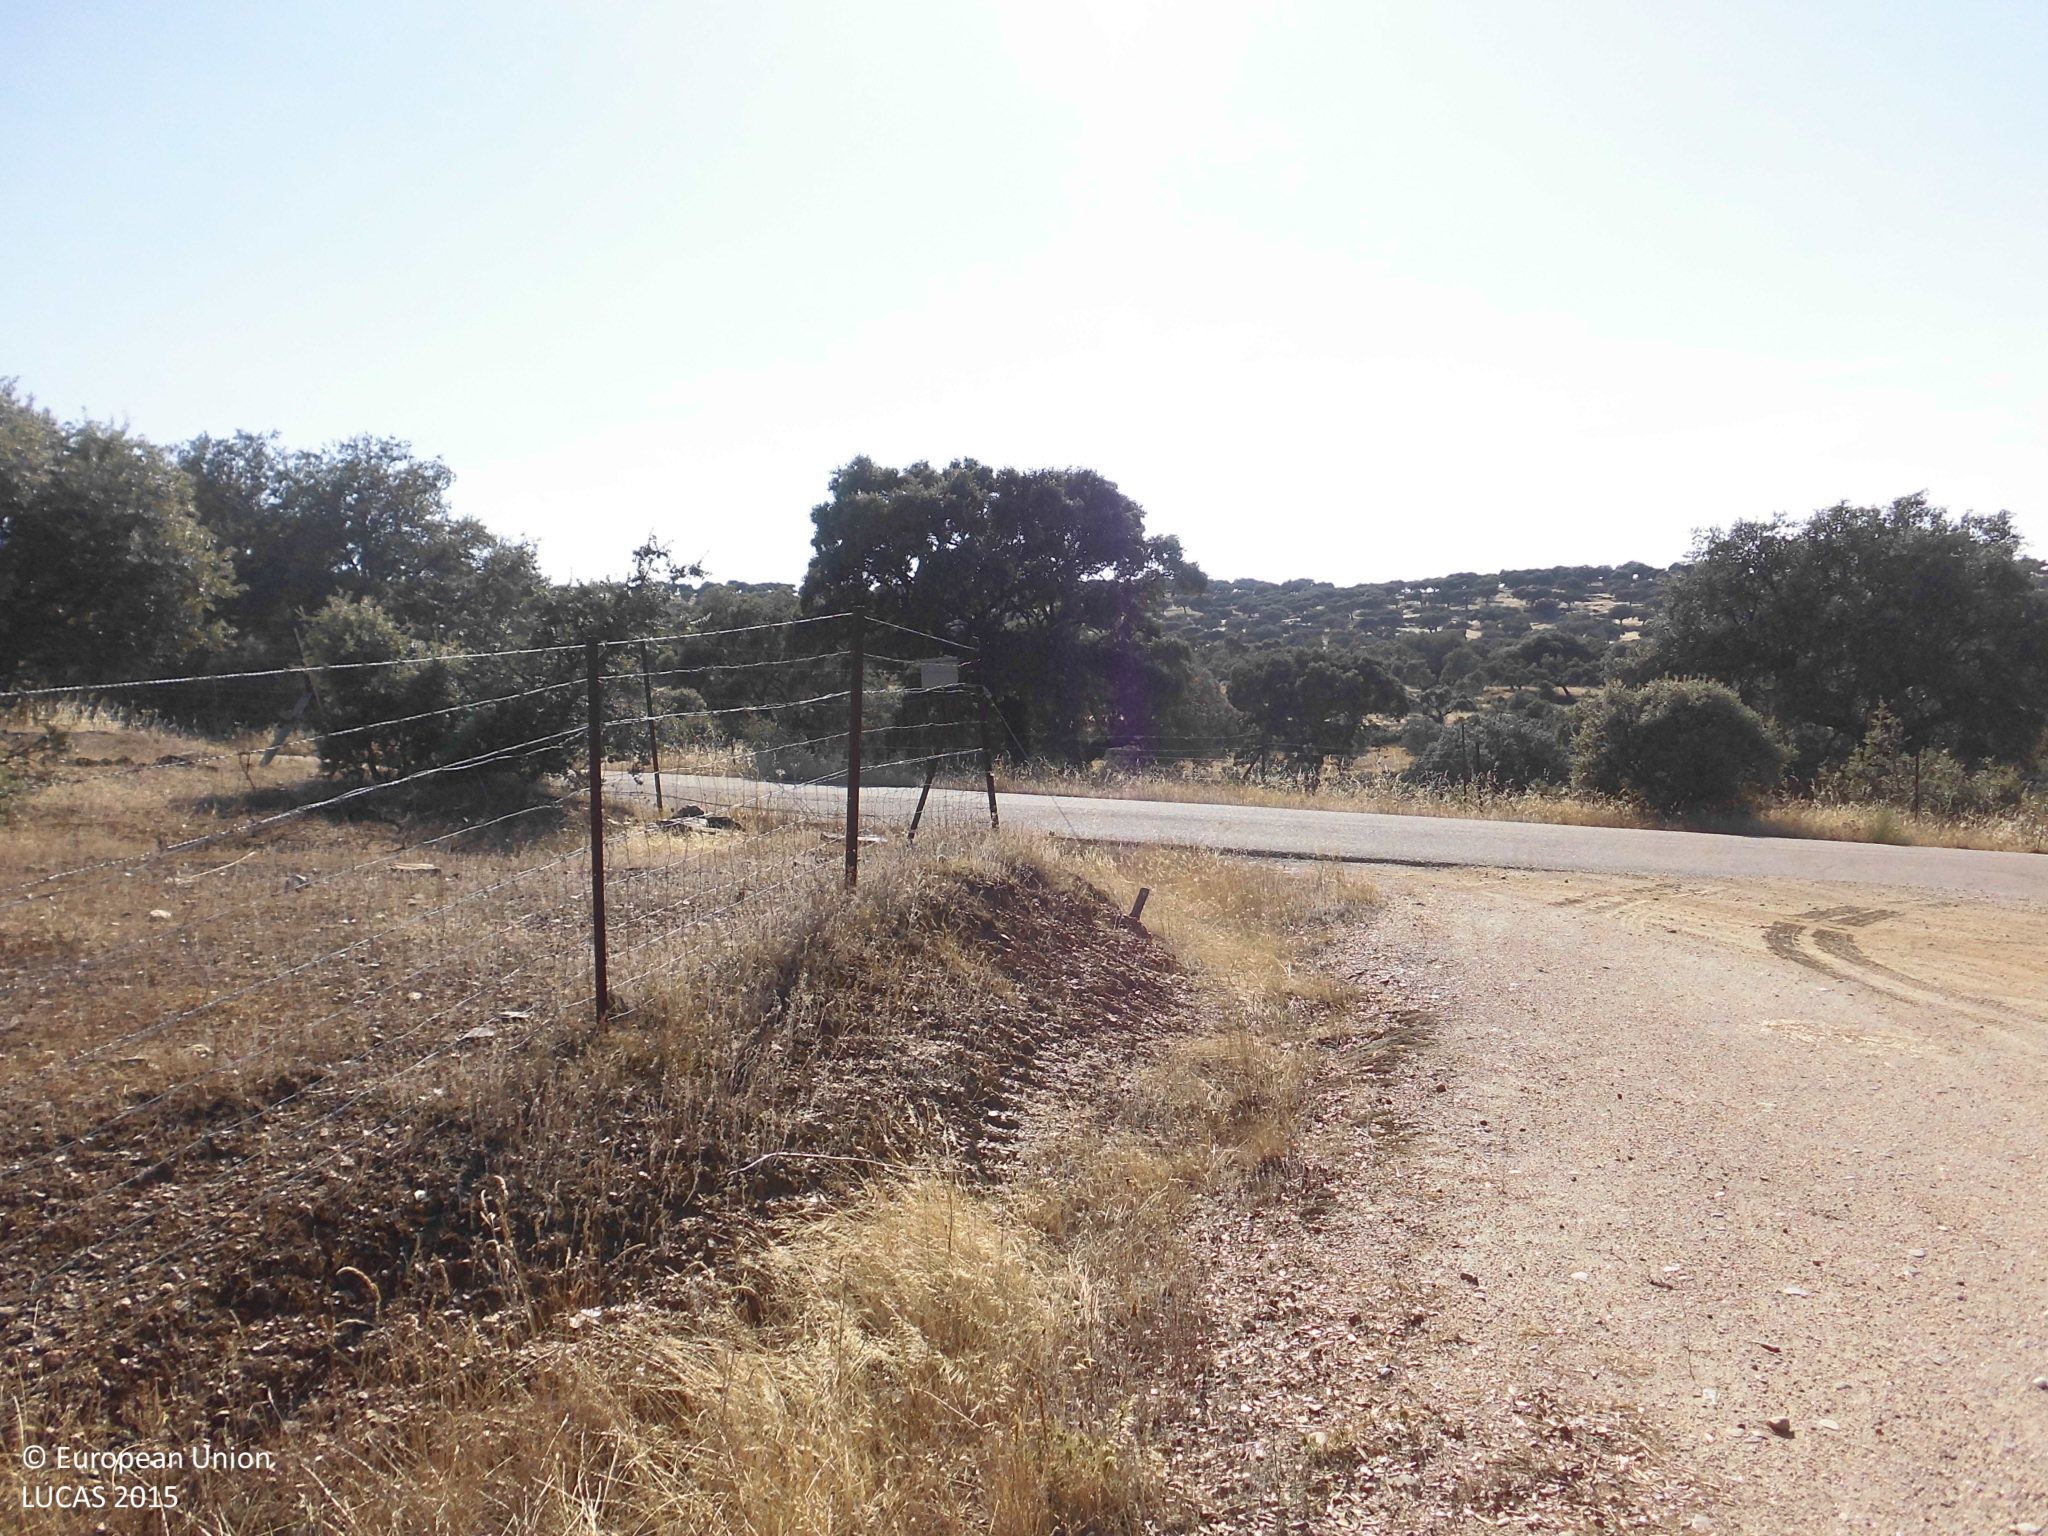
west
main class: Woodland
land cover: Broadleaved woodland
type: broadleaved evergreen forest
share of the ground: 50 - 75 %
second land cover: Grassland without tree/shrub cover
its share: > 75 %
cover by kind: broadleaved forest trees 60 %, herbaceous plants 40 %
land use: Forestry
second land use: Agriculture (excluding fallow land and kitchen gardens)
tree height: > 5 m
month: July
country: ES
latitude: 39.5282
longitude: -5.5848
